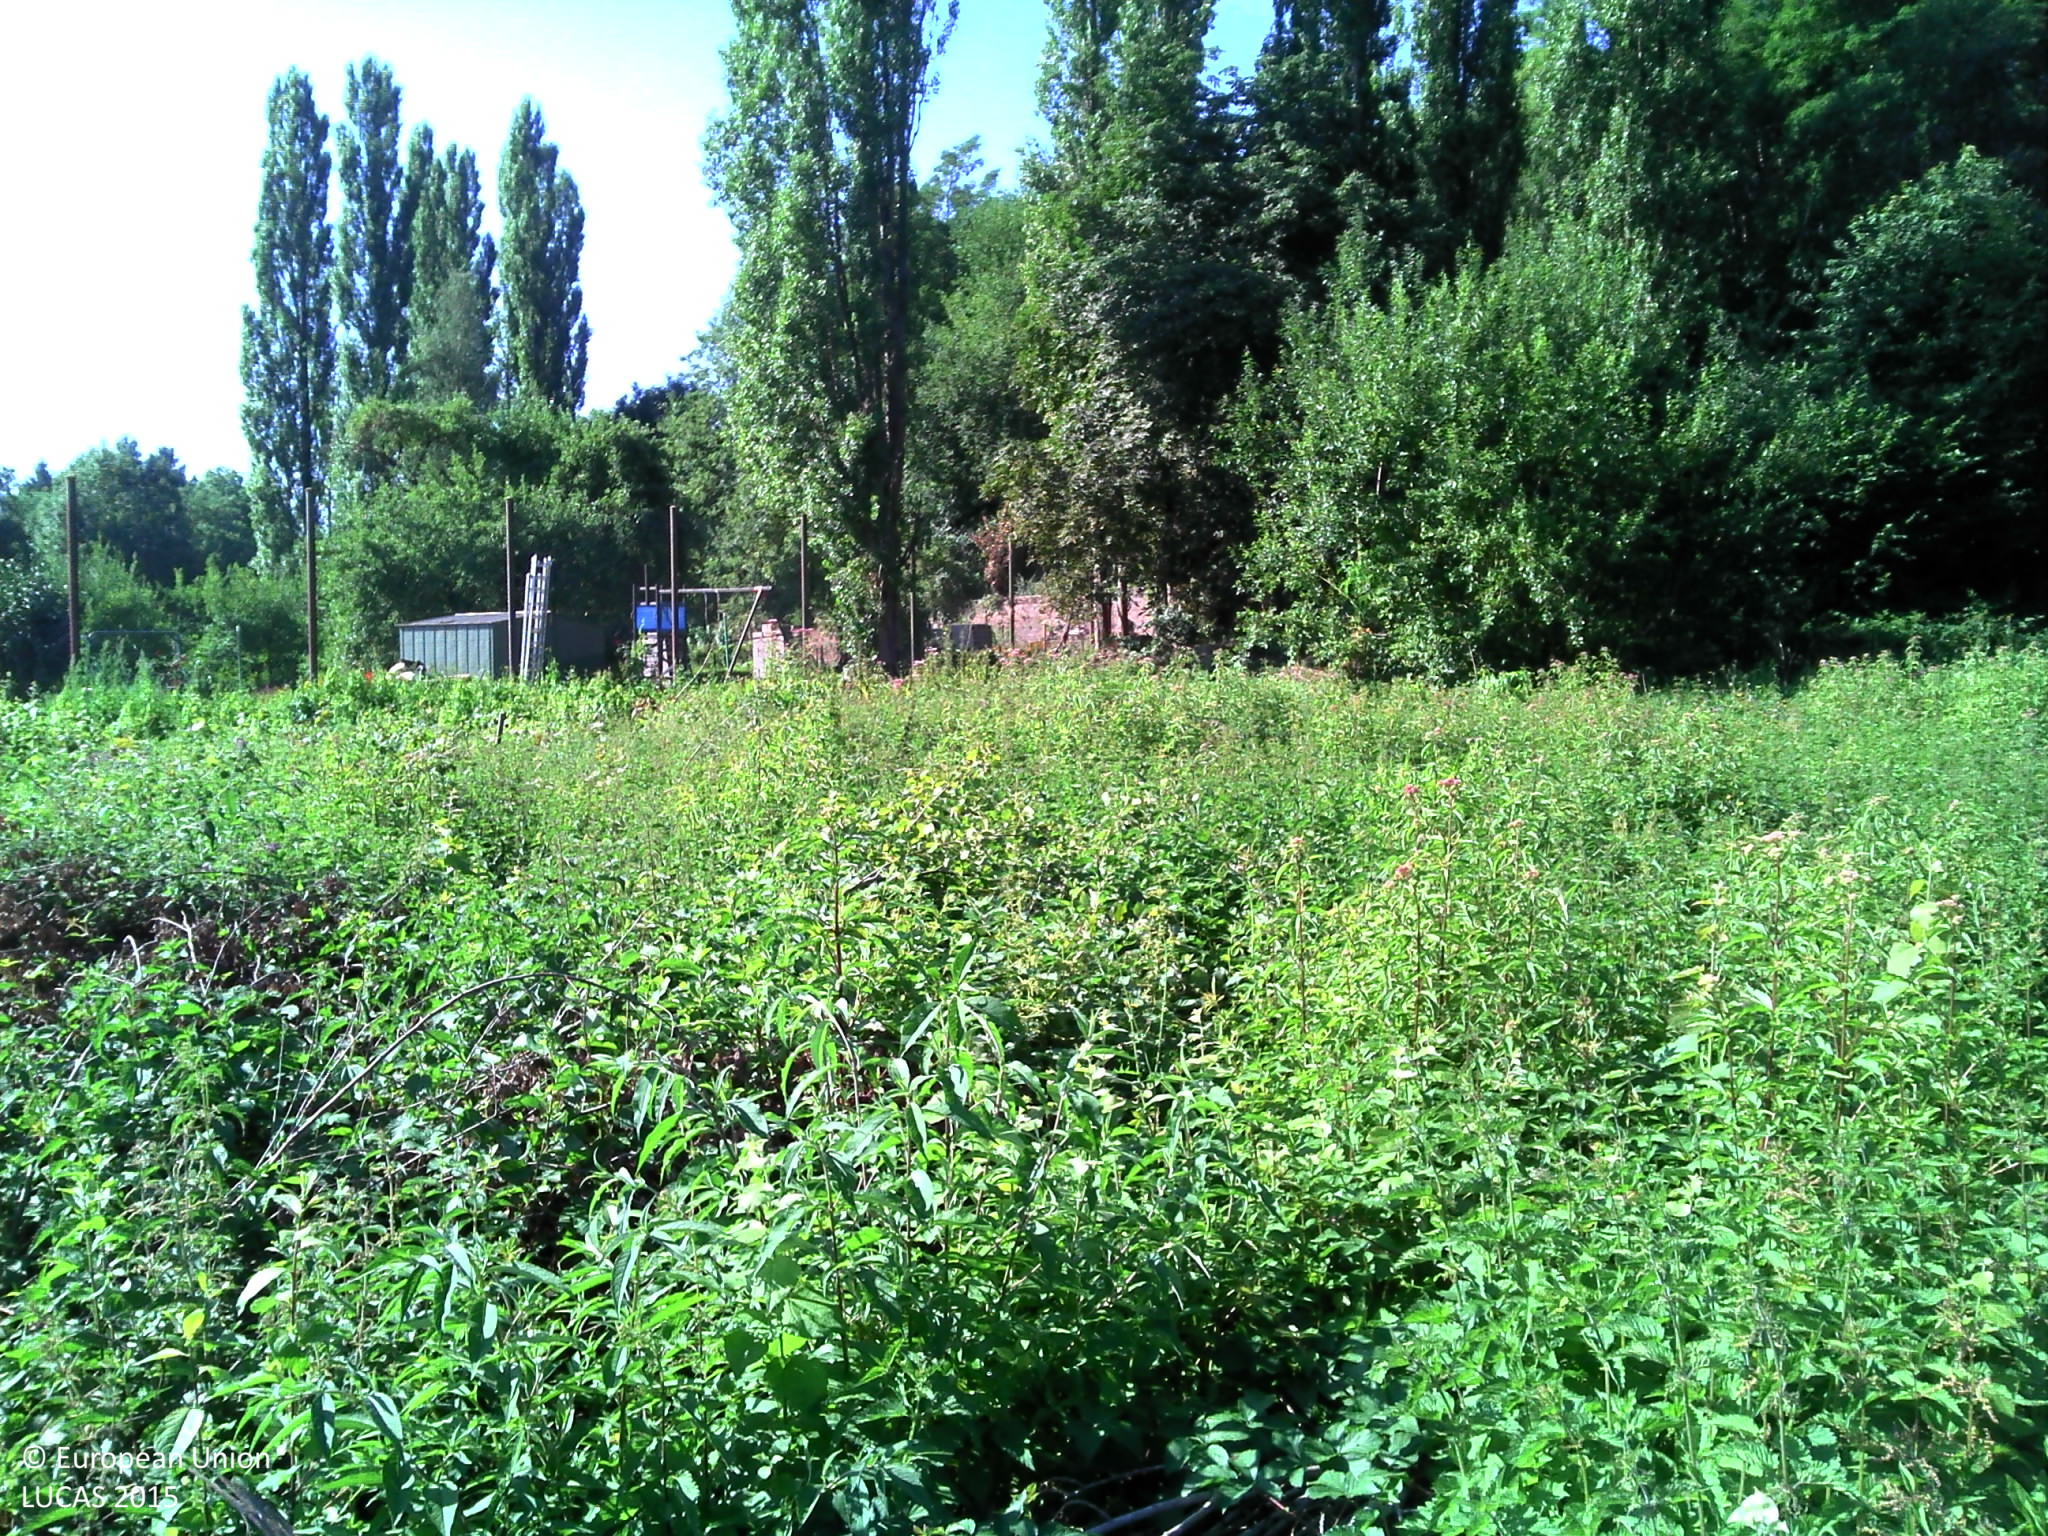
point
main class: Grassland
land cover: Spontaneously vegetated surfaces
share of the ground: > 75 %
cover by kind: herbaceous plants 95 %, shrubs 5 %
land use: Semi-natural and natural areas not in use
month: August
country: BE
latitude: 50.4144
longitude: 4.5498
